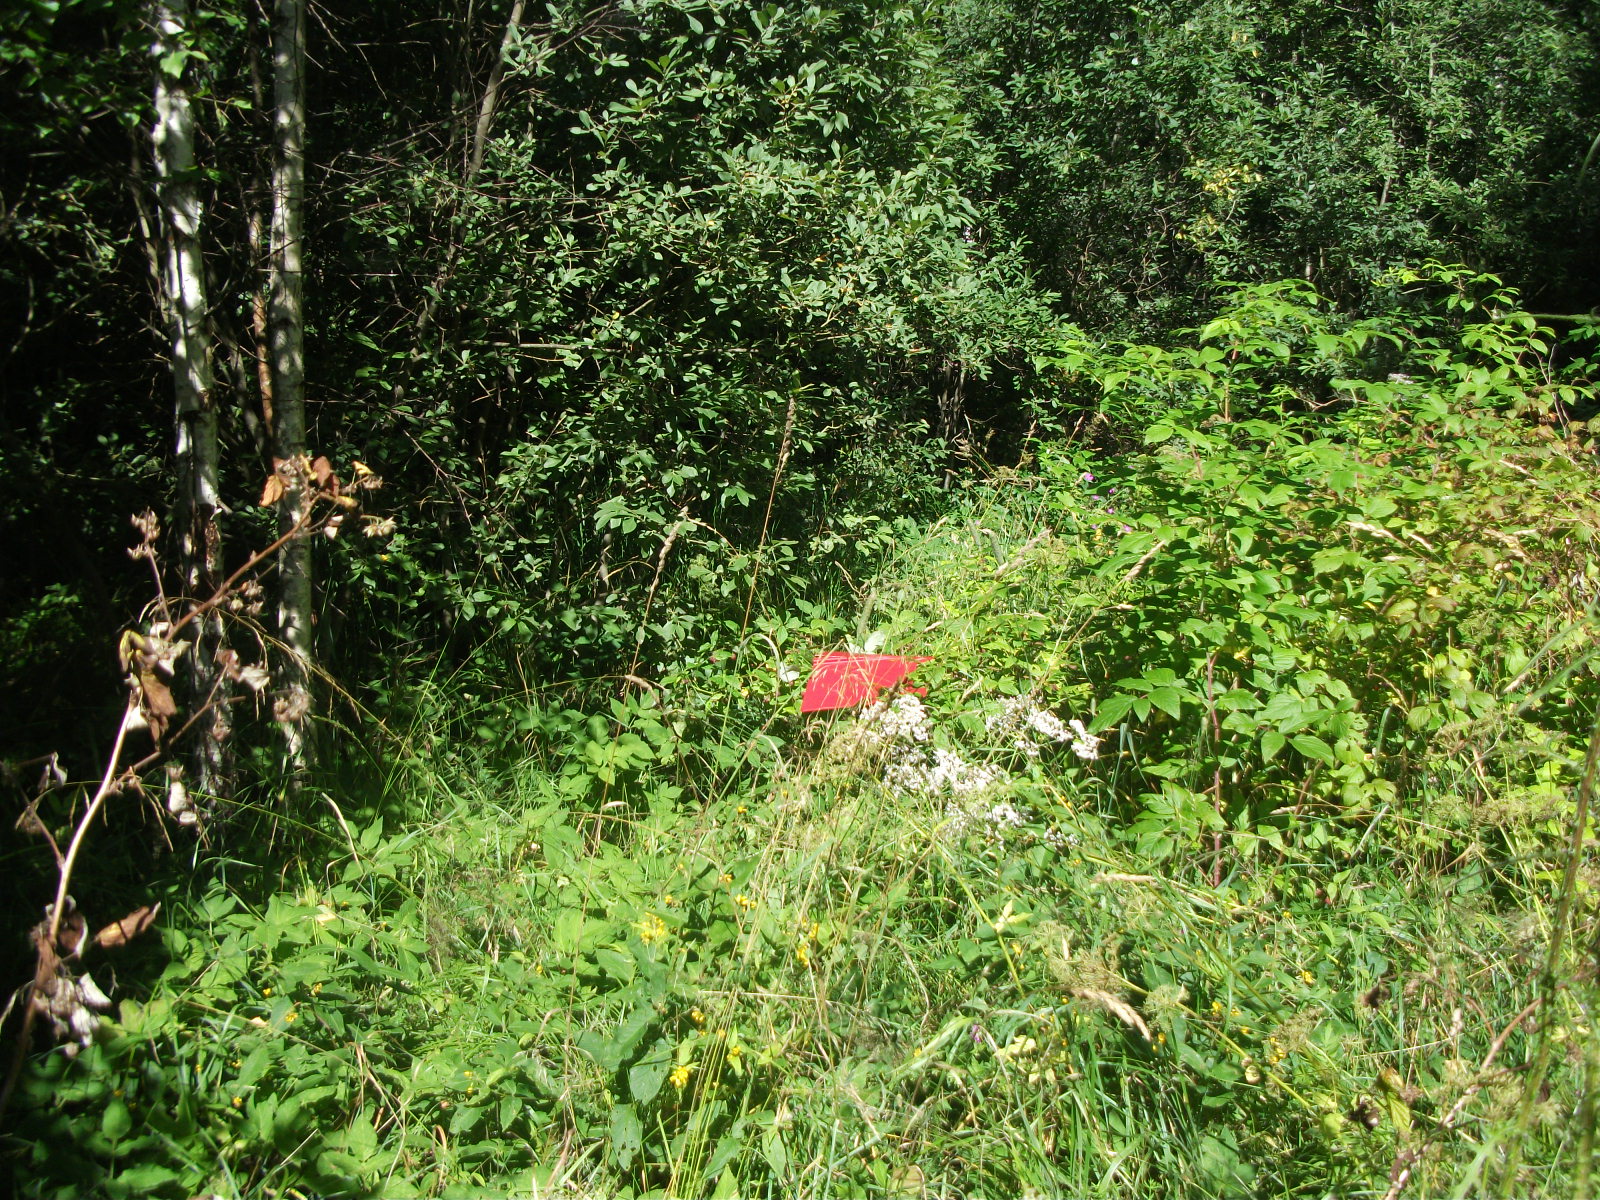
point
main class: Woodland
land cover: Broadleaved woodland
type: non-riverine alder, birch or aspen forest
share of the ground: > 75 %
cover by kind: broadleaved forest trees 75 %, shrubs 15 %, herbaceous plants 10 %
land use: Forestry
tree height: > 5 m
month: August
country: LV
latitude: 57.0050
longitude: 26.4948
